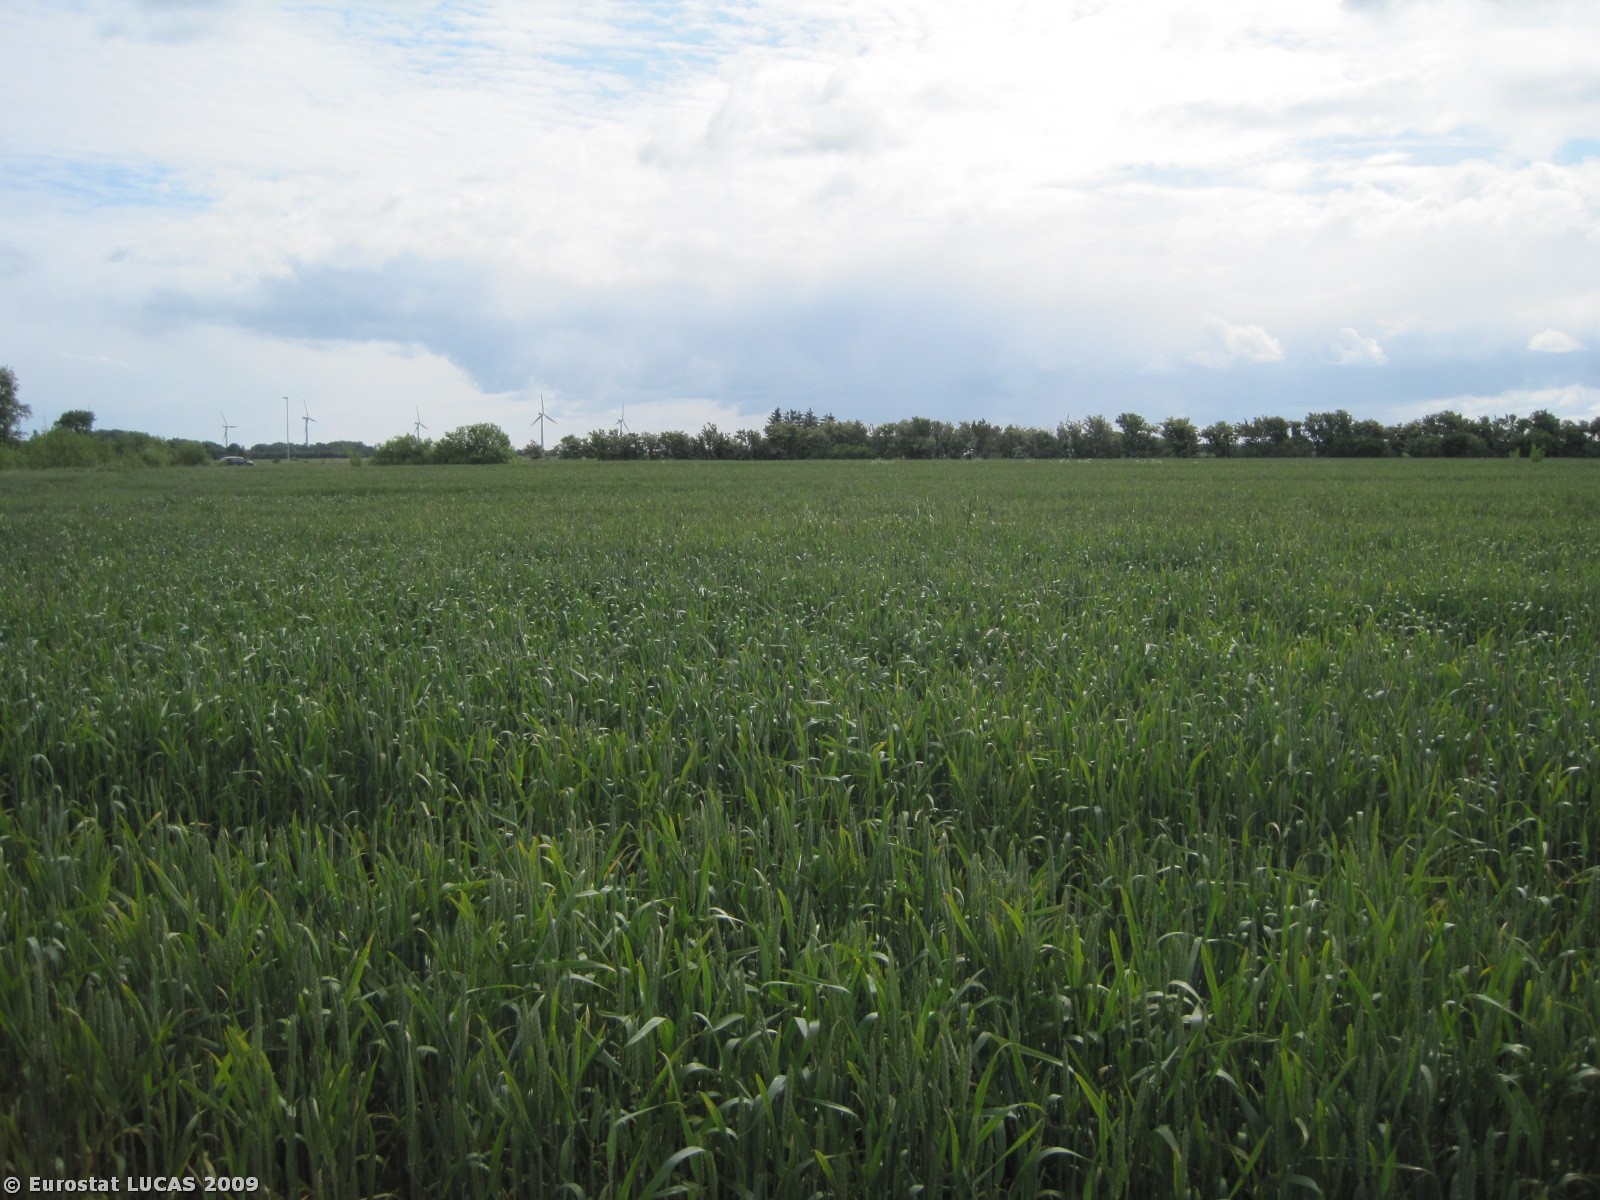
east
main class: Cropland
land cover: Common wheat
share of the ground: > 75 %
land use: Agriculture (excluding fallow land and kitchen gardens)
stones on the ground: < 10 %
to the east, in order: Common wheat; Grass margins; Ditches and canals; Grass margins; Common wheat; Grass margins; Ditches and canals; Grass margins; Broadleaved woodland; Grass margins; Ditches and canals; Grassland without tree/shrub cover; Tracks; Paved roads, cycling and walking lanes; Grass margins; Ditches and canals; Grassland without tree/shrub cover; Common wheat
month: June
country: DK
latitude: 57.0505
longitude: 10.1811
